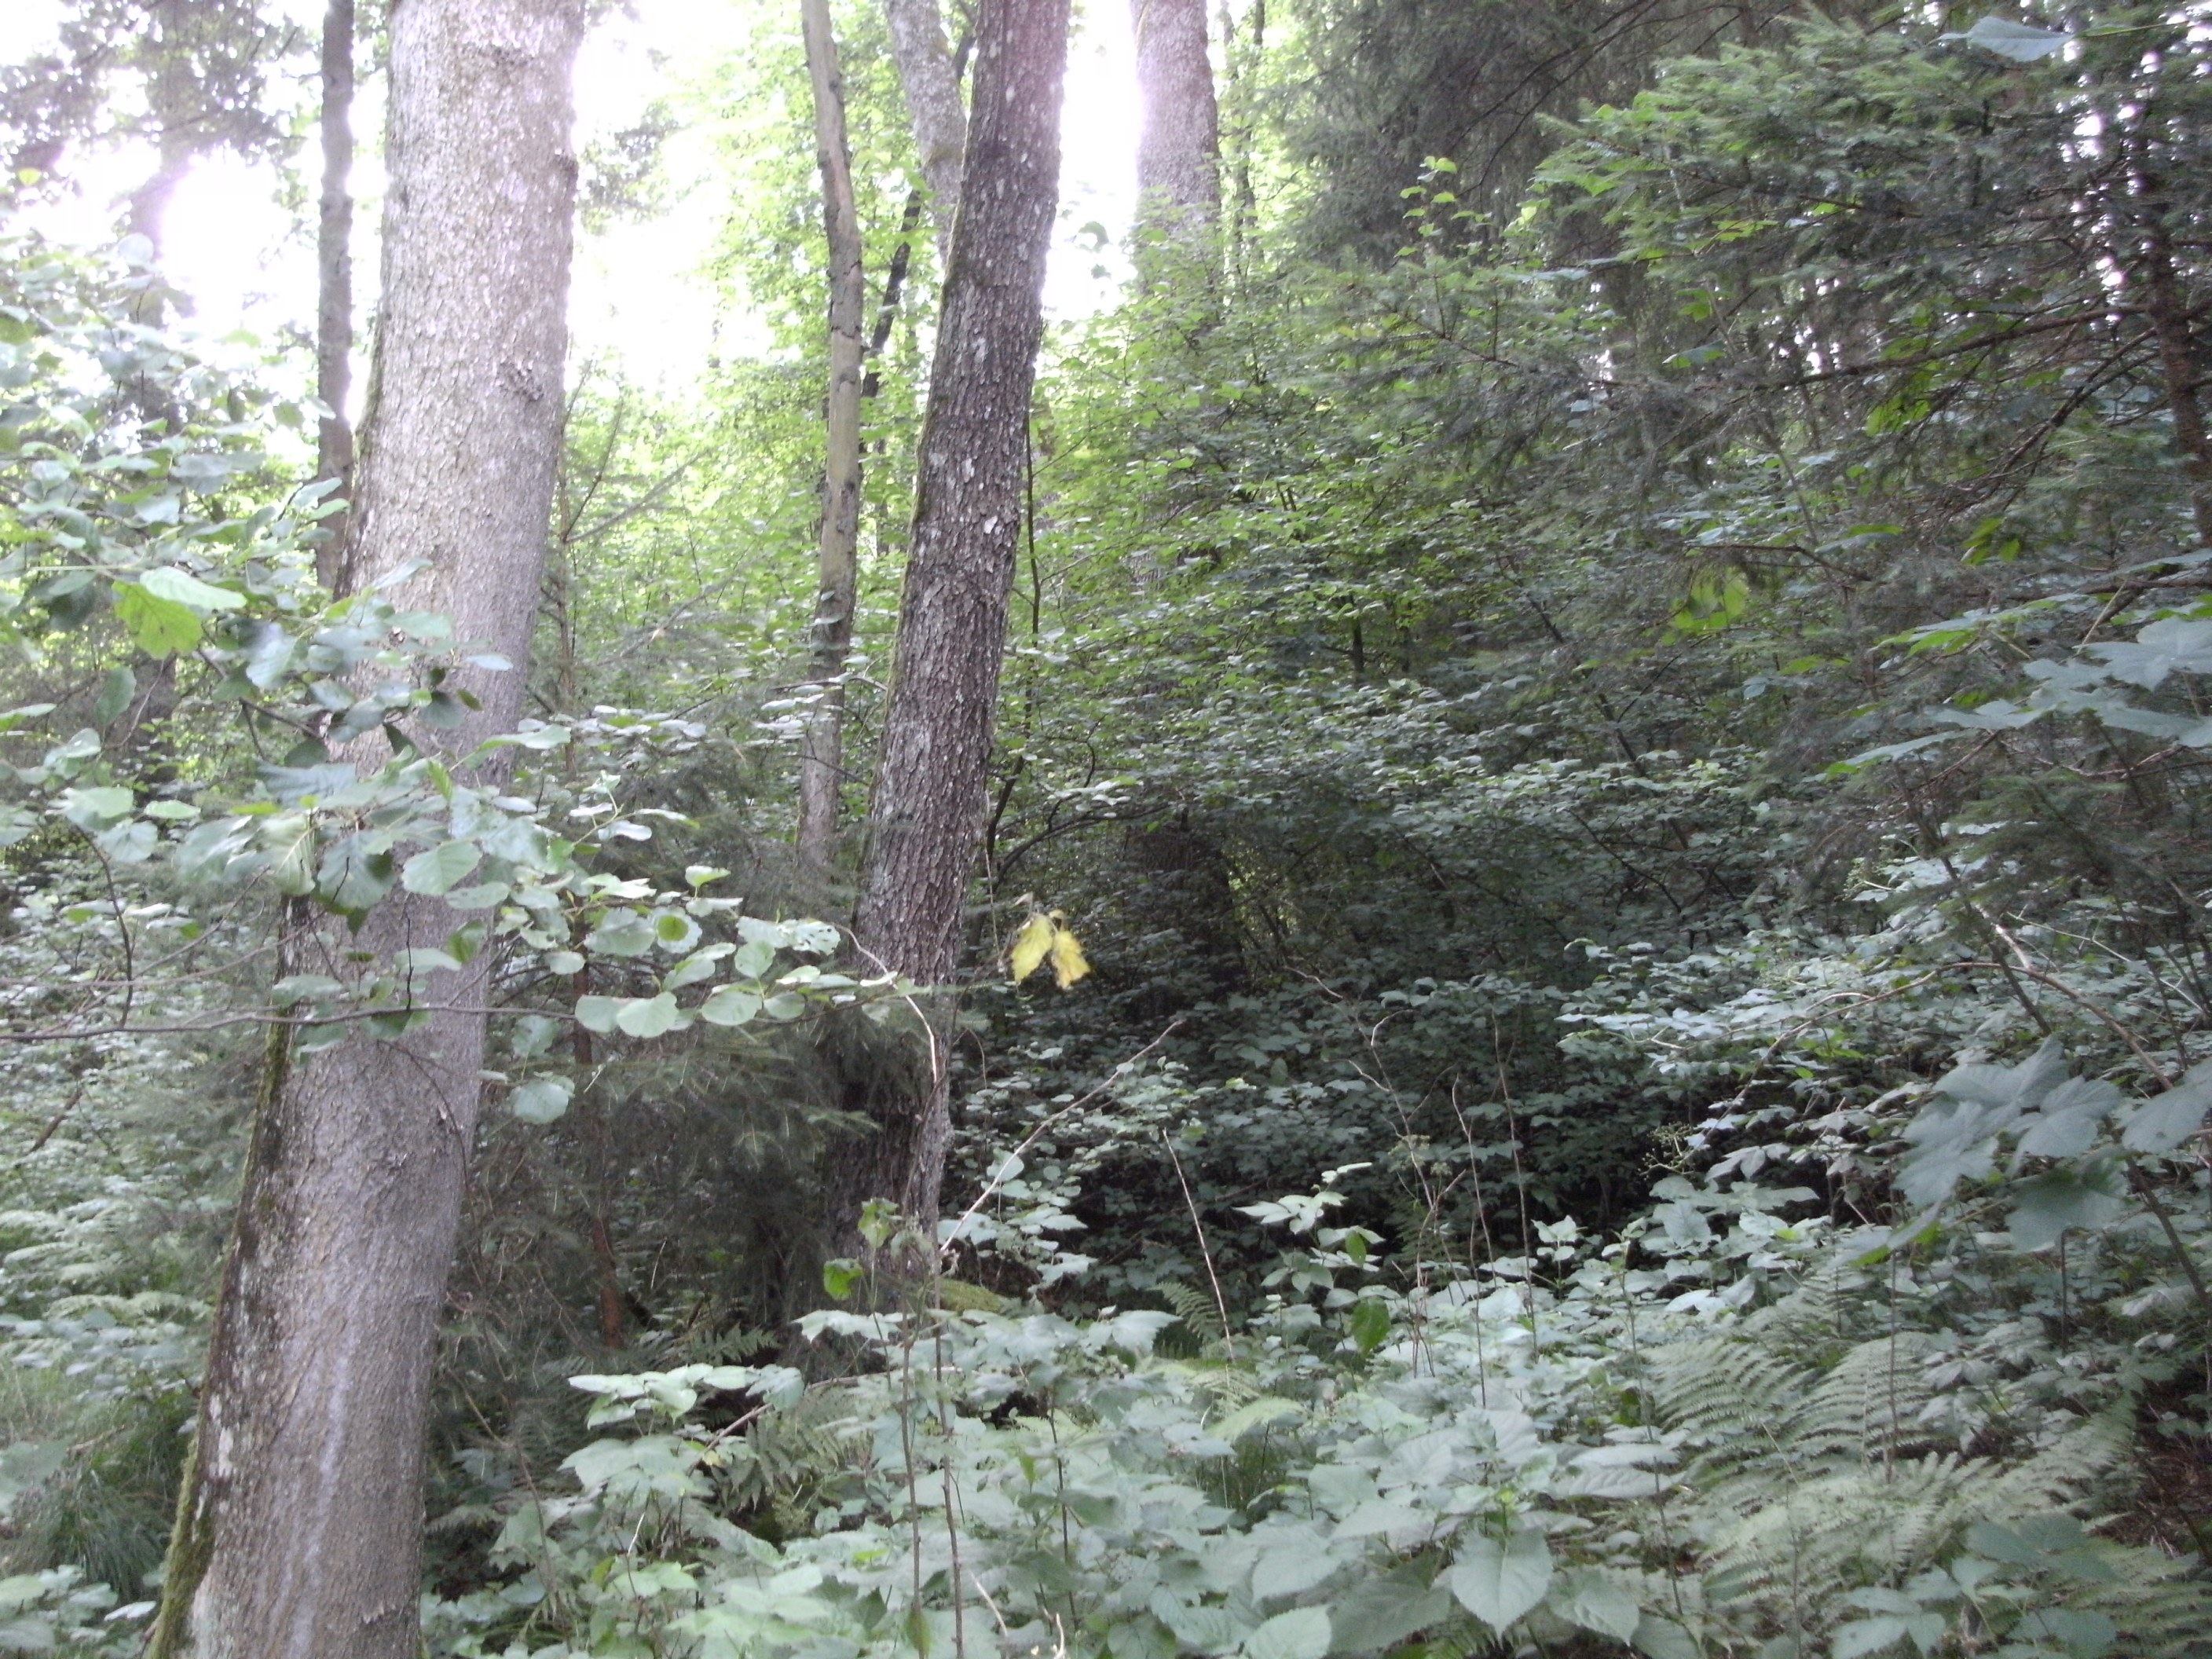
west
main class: Woodland
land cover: Spruce dominated mixed woodland
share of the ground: > 75 %
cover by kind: coniferous forest trees 40 %, broadleaved forest trees 40 %, shrubs 10 %, herbaceous plants 10 %
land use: Forestry
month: July
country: AT
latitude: 46.8036
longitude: 14.7809
